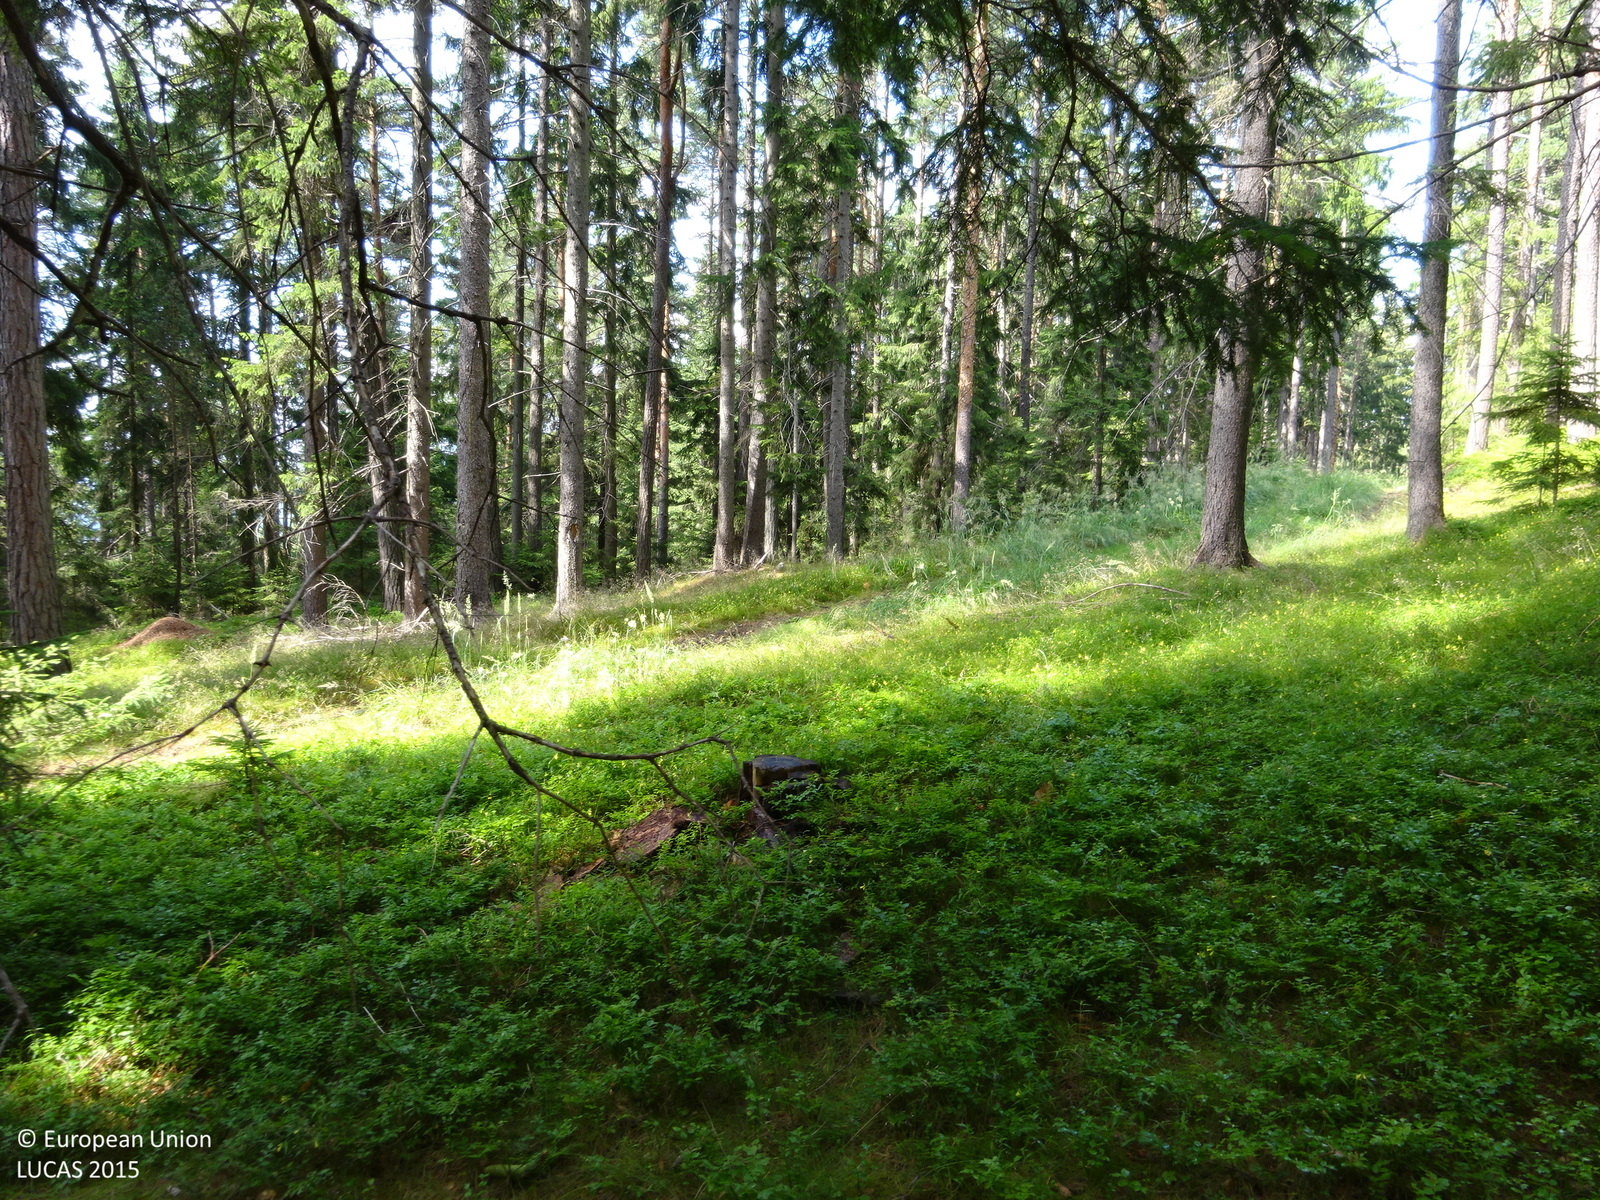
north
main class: Woodland
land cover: Spruce dominated coniferous woodland
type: alpine coniferous forest
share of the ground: > 75 %
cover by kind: coniferous forest trees 80 %, shrubs 10 %, herbaceous plants 10 %
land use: Forestry
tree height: > 5 m
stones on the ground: < 10 %
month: July
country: AT
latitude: 47.2240
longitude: 15.4280
